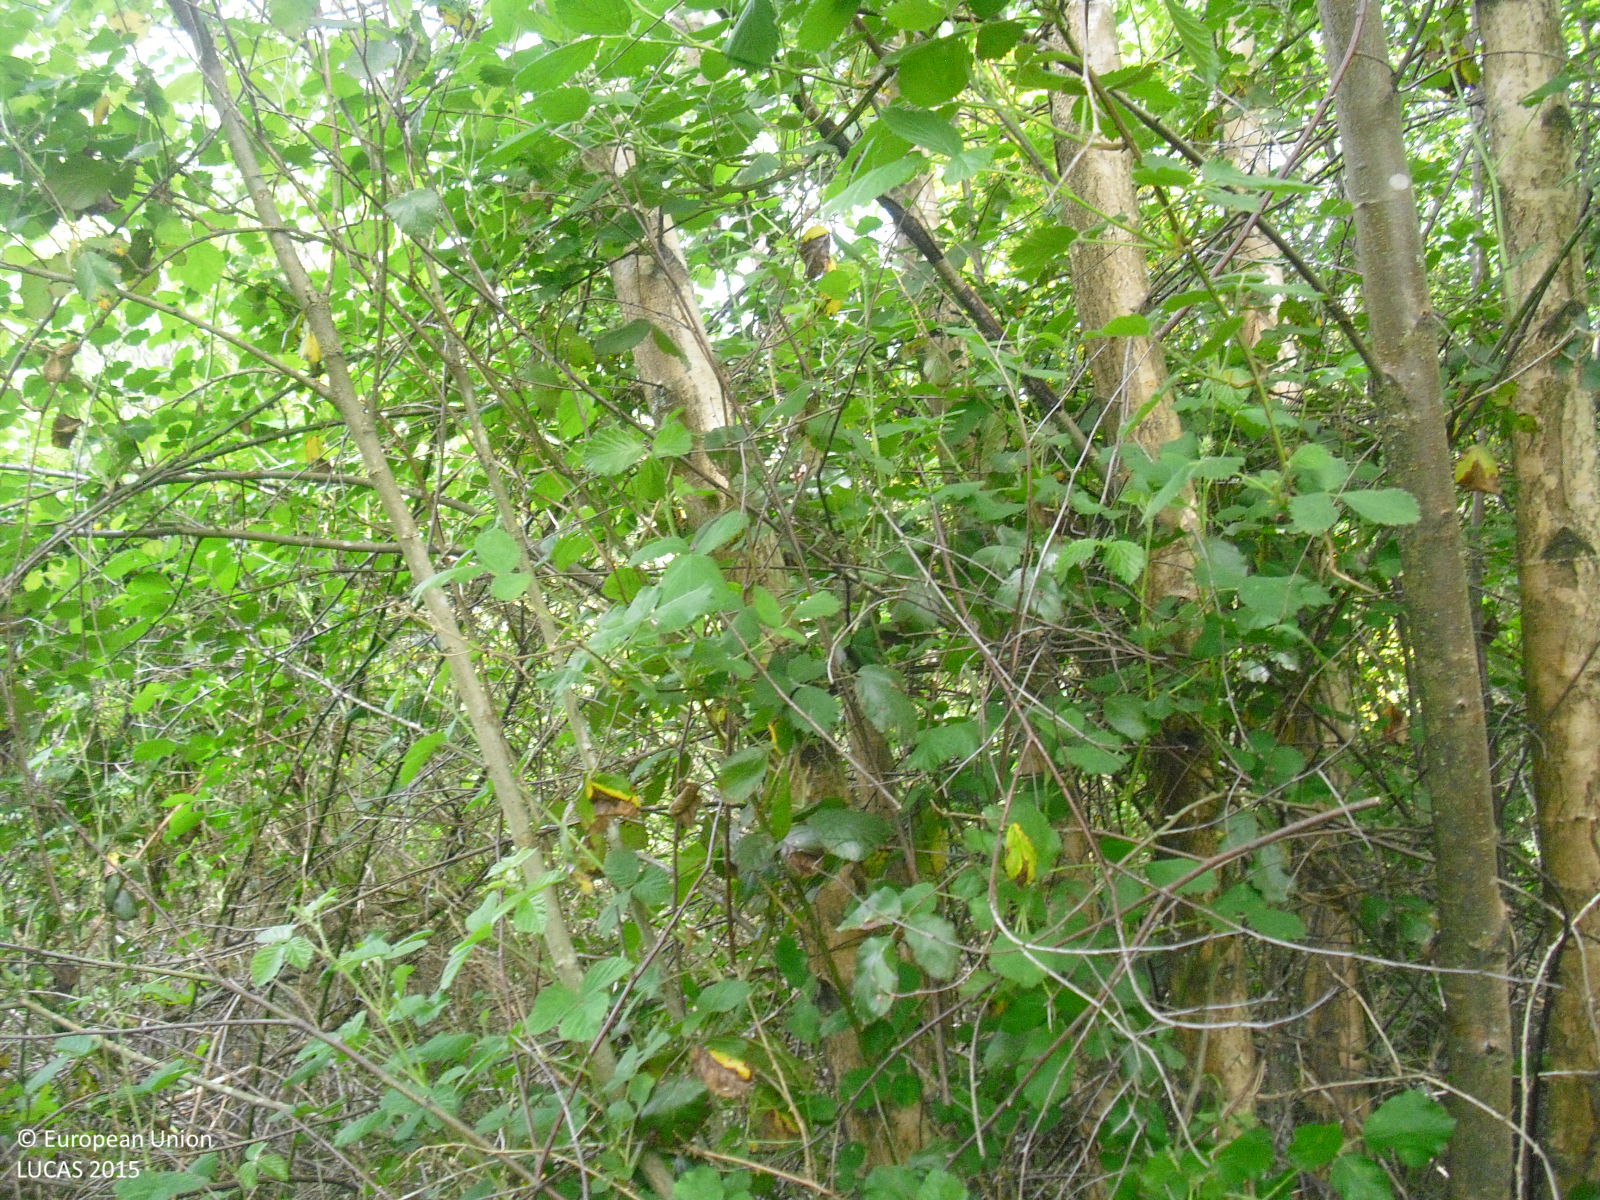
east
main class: Woodland
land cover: Broadleaved woodland
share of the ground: 50 - 75 %
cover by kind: broadleaved forest trees 60 %, shrubs 40 %
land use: Abandoned areas
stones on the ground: < 10 %
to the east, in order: Broadleaved woodland; Dry stone walls; Shruby margins; Spontaneously vegetated surfaces; Shrubland with sparse tree cover; Shrubland without tree cover; Broadleaved woodland; Grass margins; Tracks; Grass margins; Broadleaved woodland; Dry stone walls; Shrubland without tree cover; Tracks; Shrubland without tree cover; Shrubland with sparse tree cover; Broadleaved woodland
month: May
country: ES
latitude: 42.1420
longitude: -7.8485
